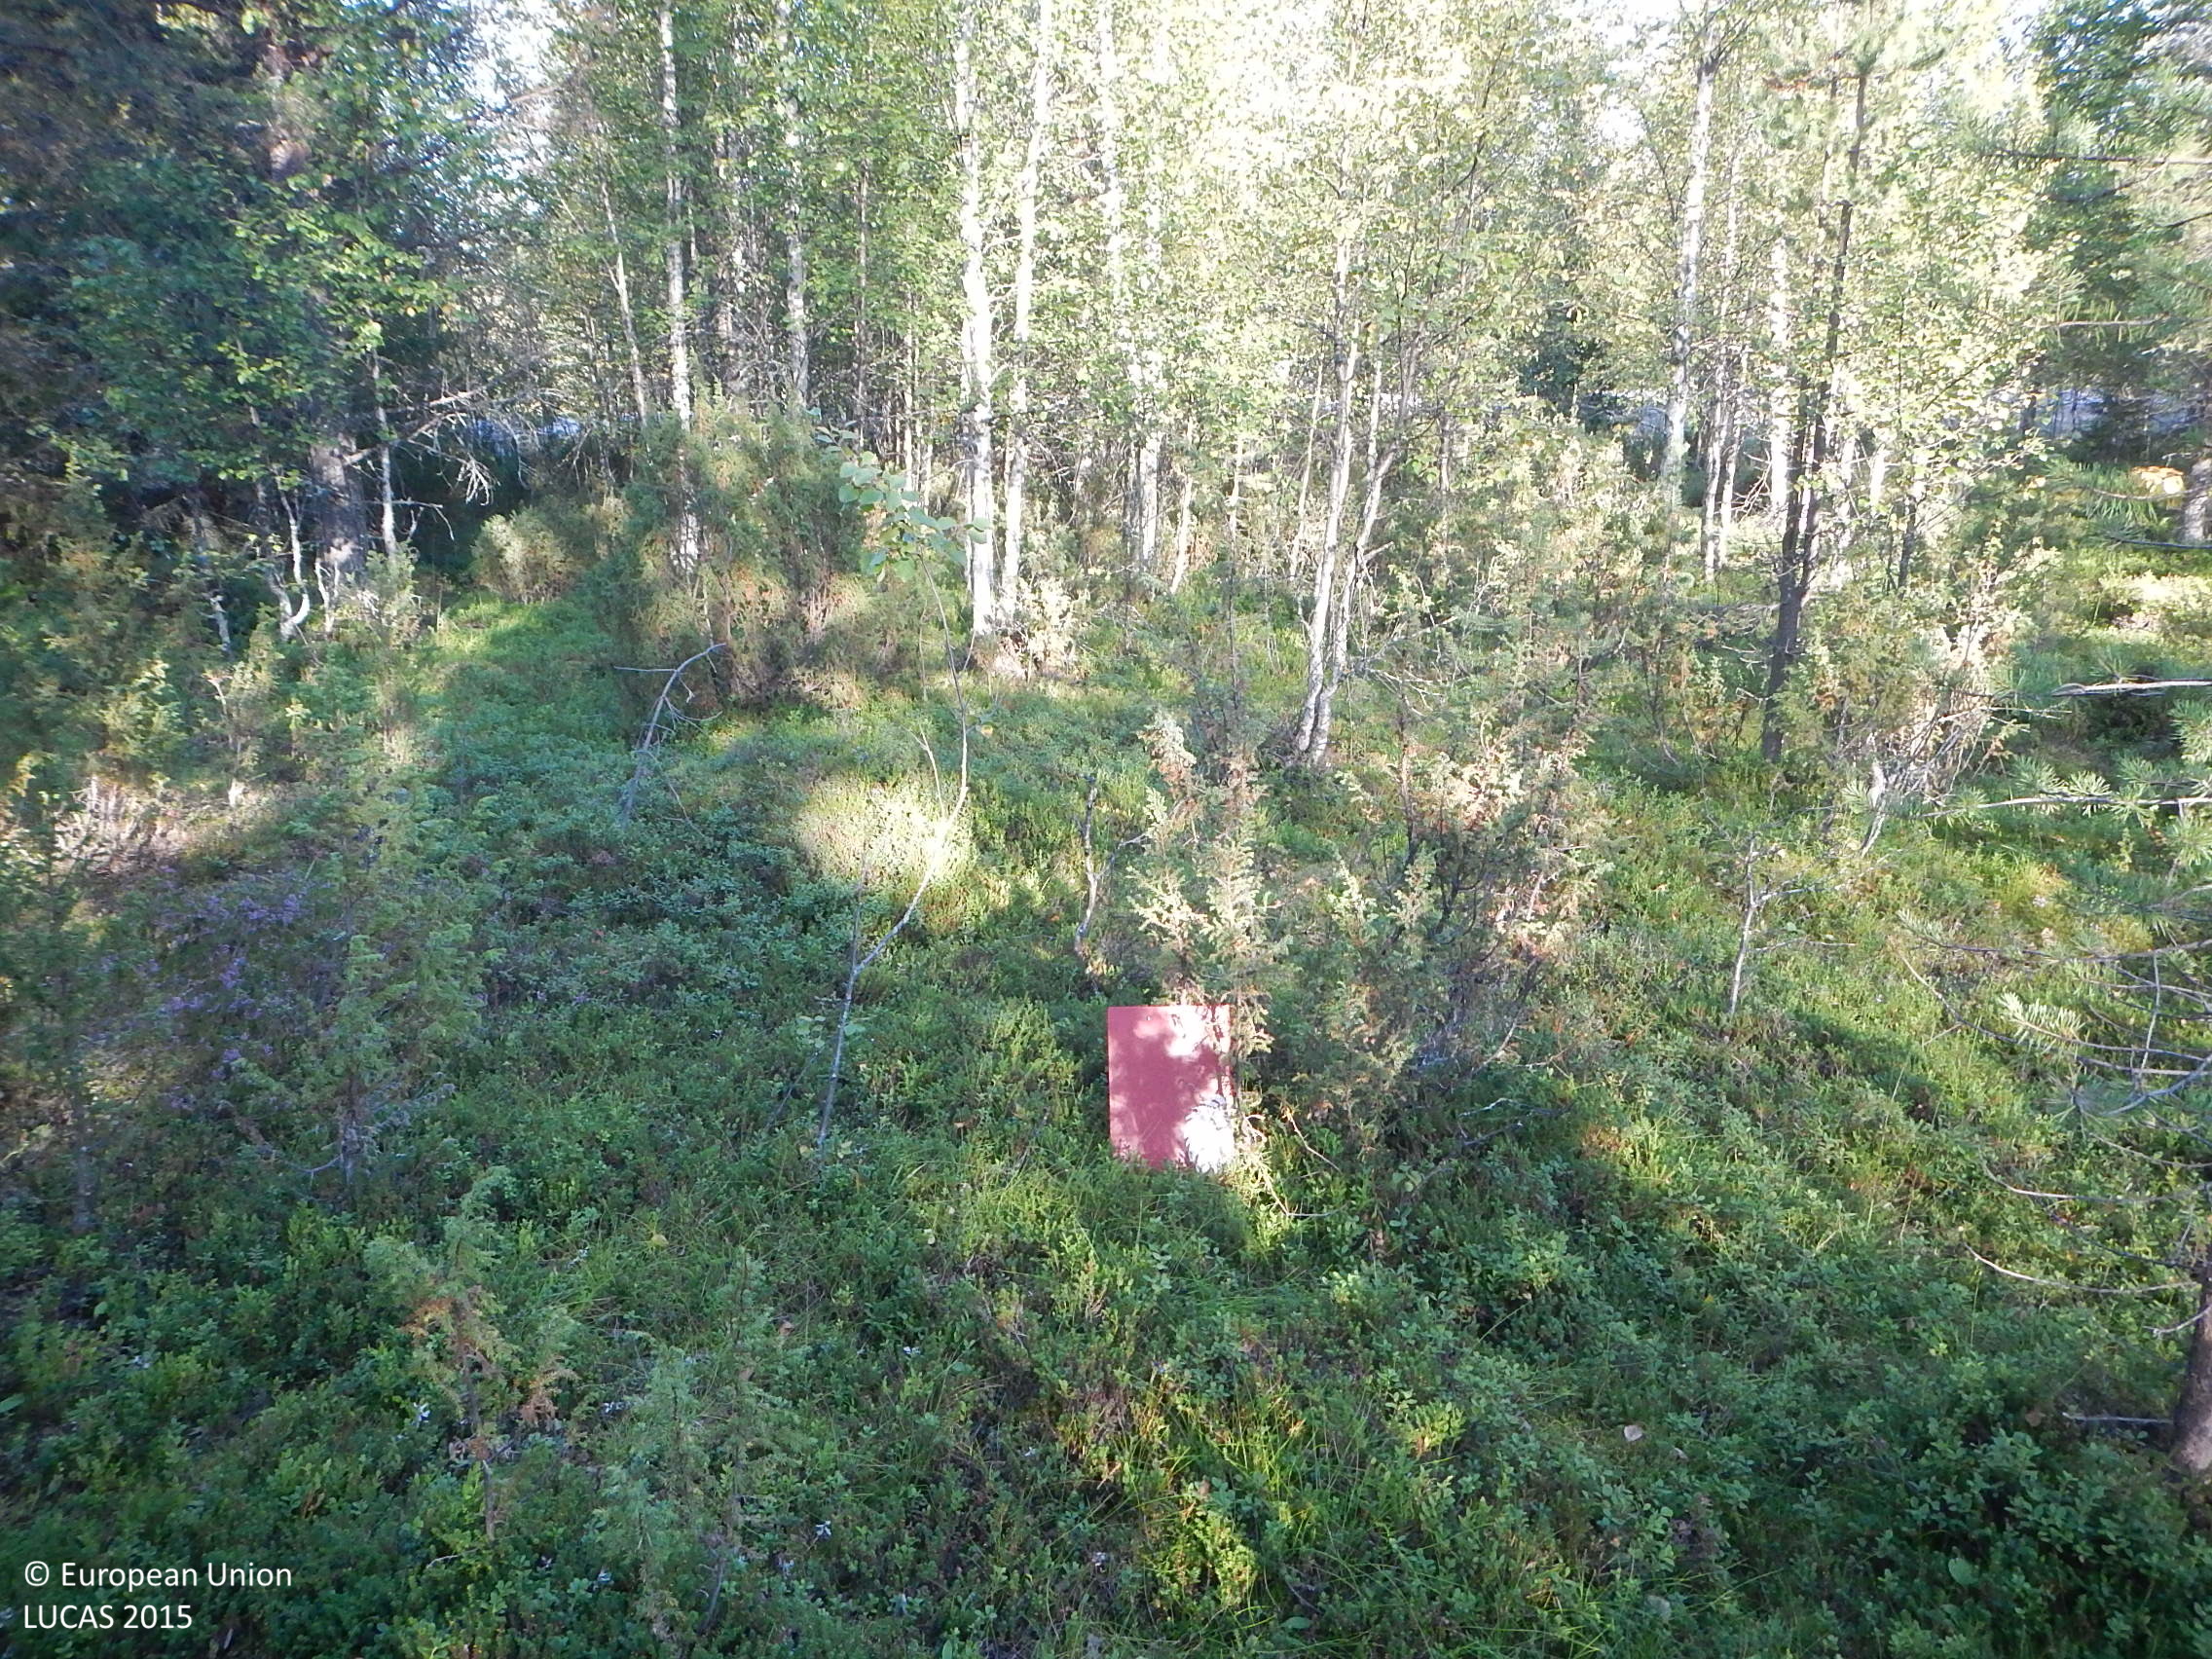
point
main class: Woodland
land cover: Pine dominated mixed woodland
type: boreal forest
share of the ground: 50 - 75 %
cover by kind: shrubs 45 %, coniferous forest trees 25 %, broadleaved forest trees 25 %, lichens and mosses 5 %
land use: Forestry
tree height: > 5 m
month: August
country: FI
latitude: 66.7108
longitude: 28.9006
